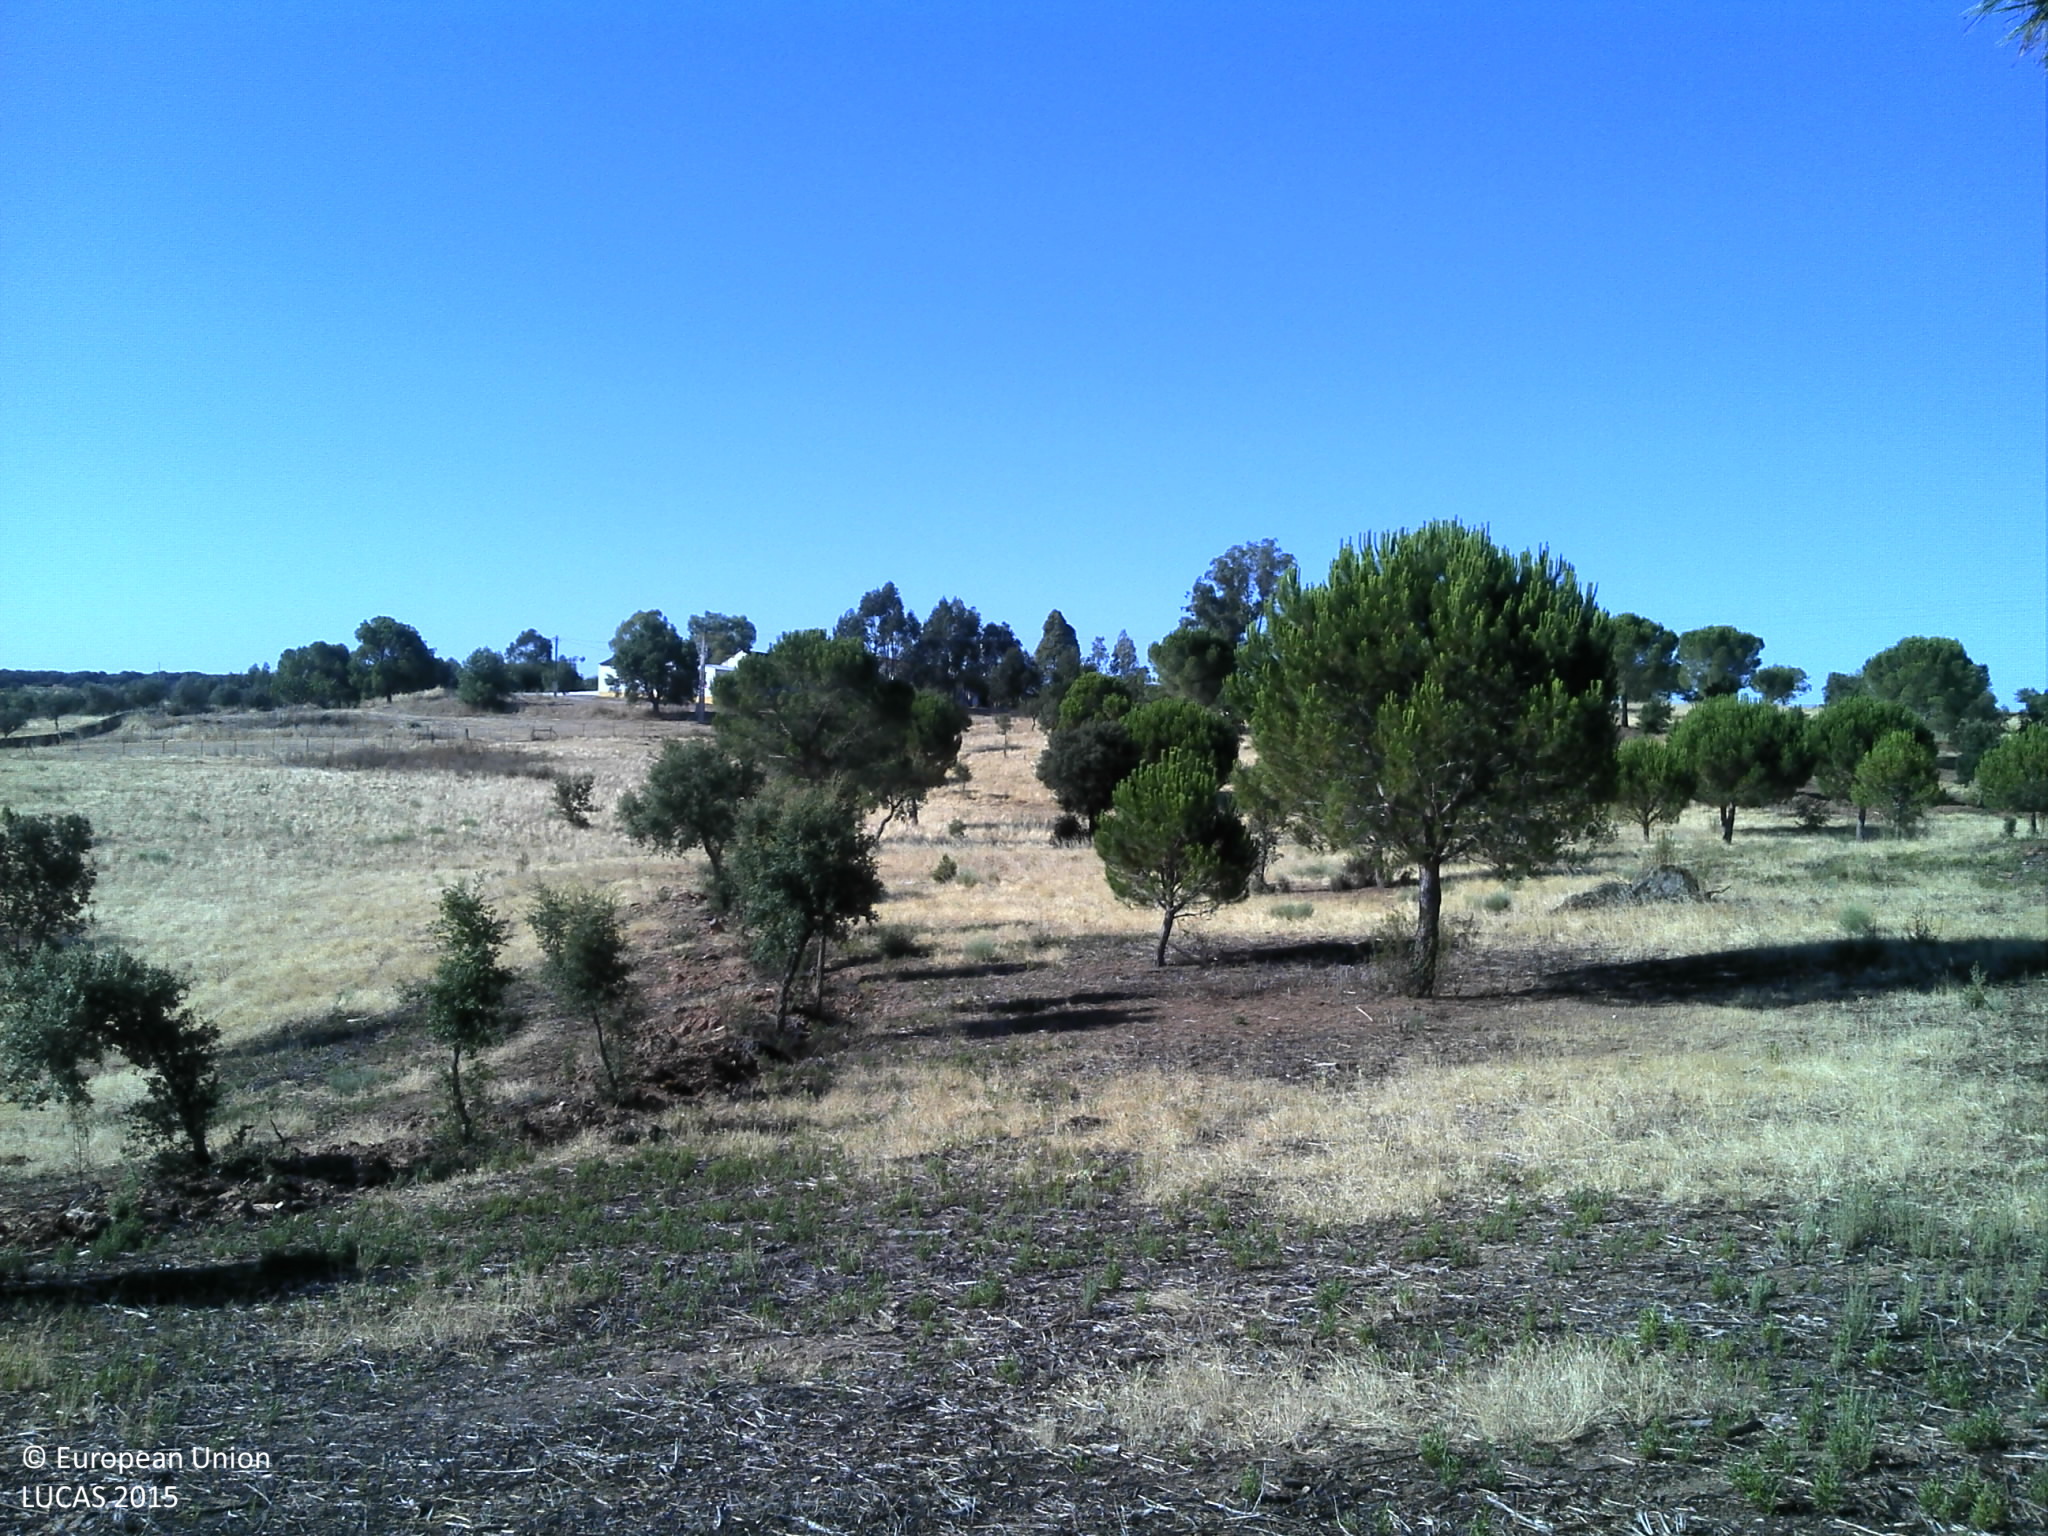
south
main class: Woodland
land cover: Pine dominated coniferous woodland
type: coniferous forest of the mediterranean region
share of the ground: 10 - 25 %
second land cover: Grassland without tree/shrub cover
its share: 25 - 50 %
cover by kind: unconsolidated bare surface 55 %, coniferous forest trees 25 %, herbaceous plants 20 %
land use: Forestry
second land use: Agriculture (excluding fallow land and kitchen gardens)
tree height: > 5 m
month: July
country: PT
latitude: 38.9364
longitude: -7.5146
